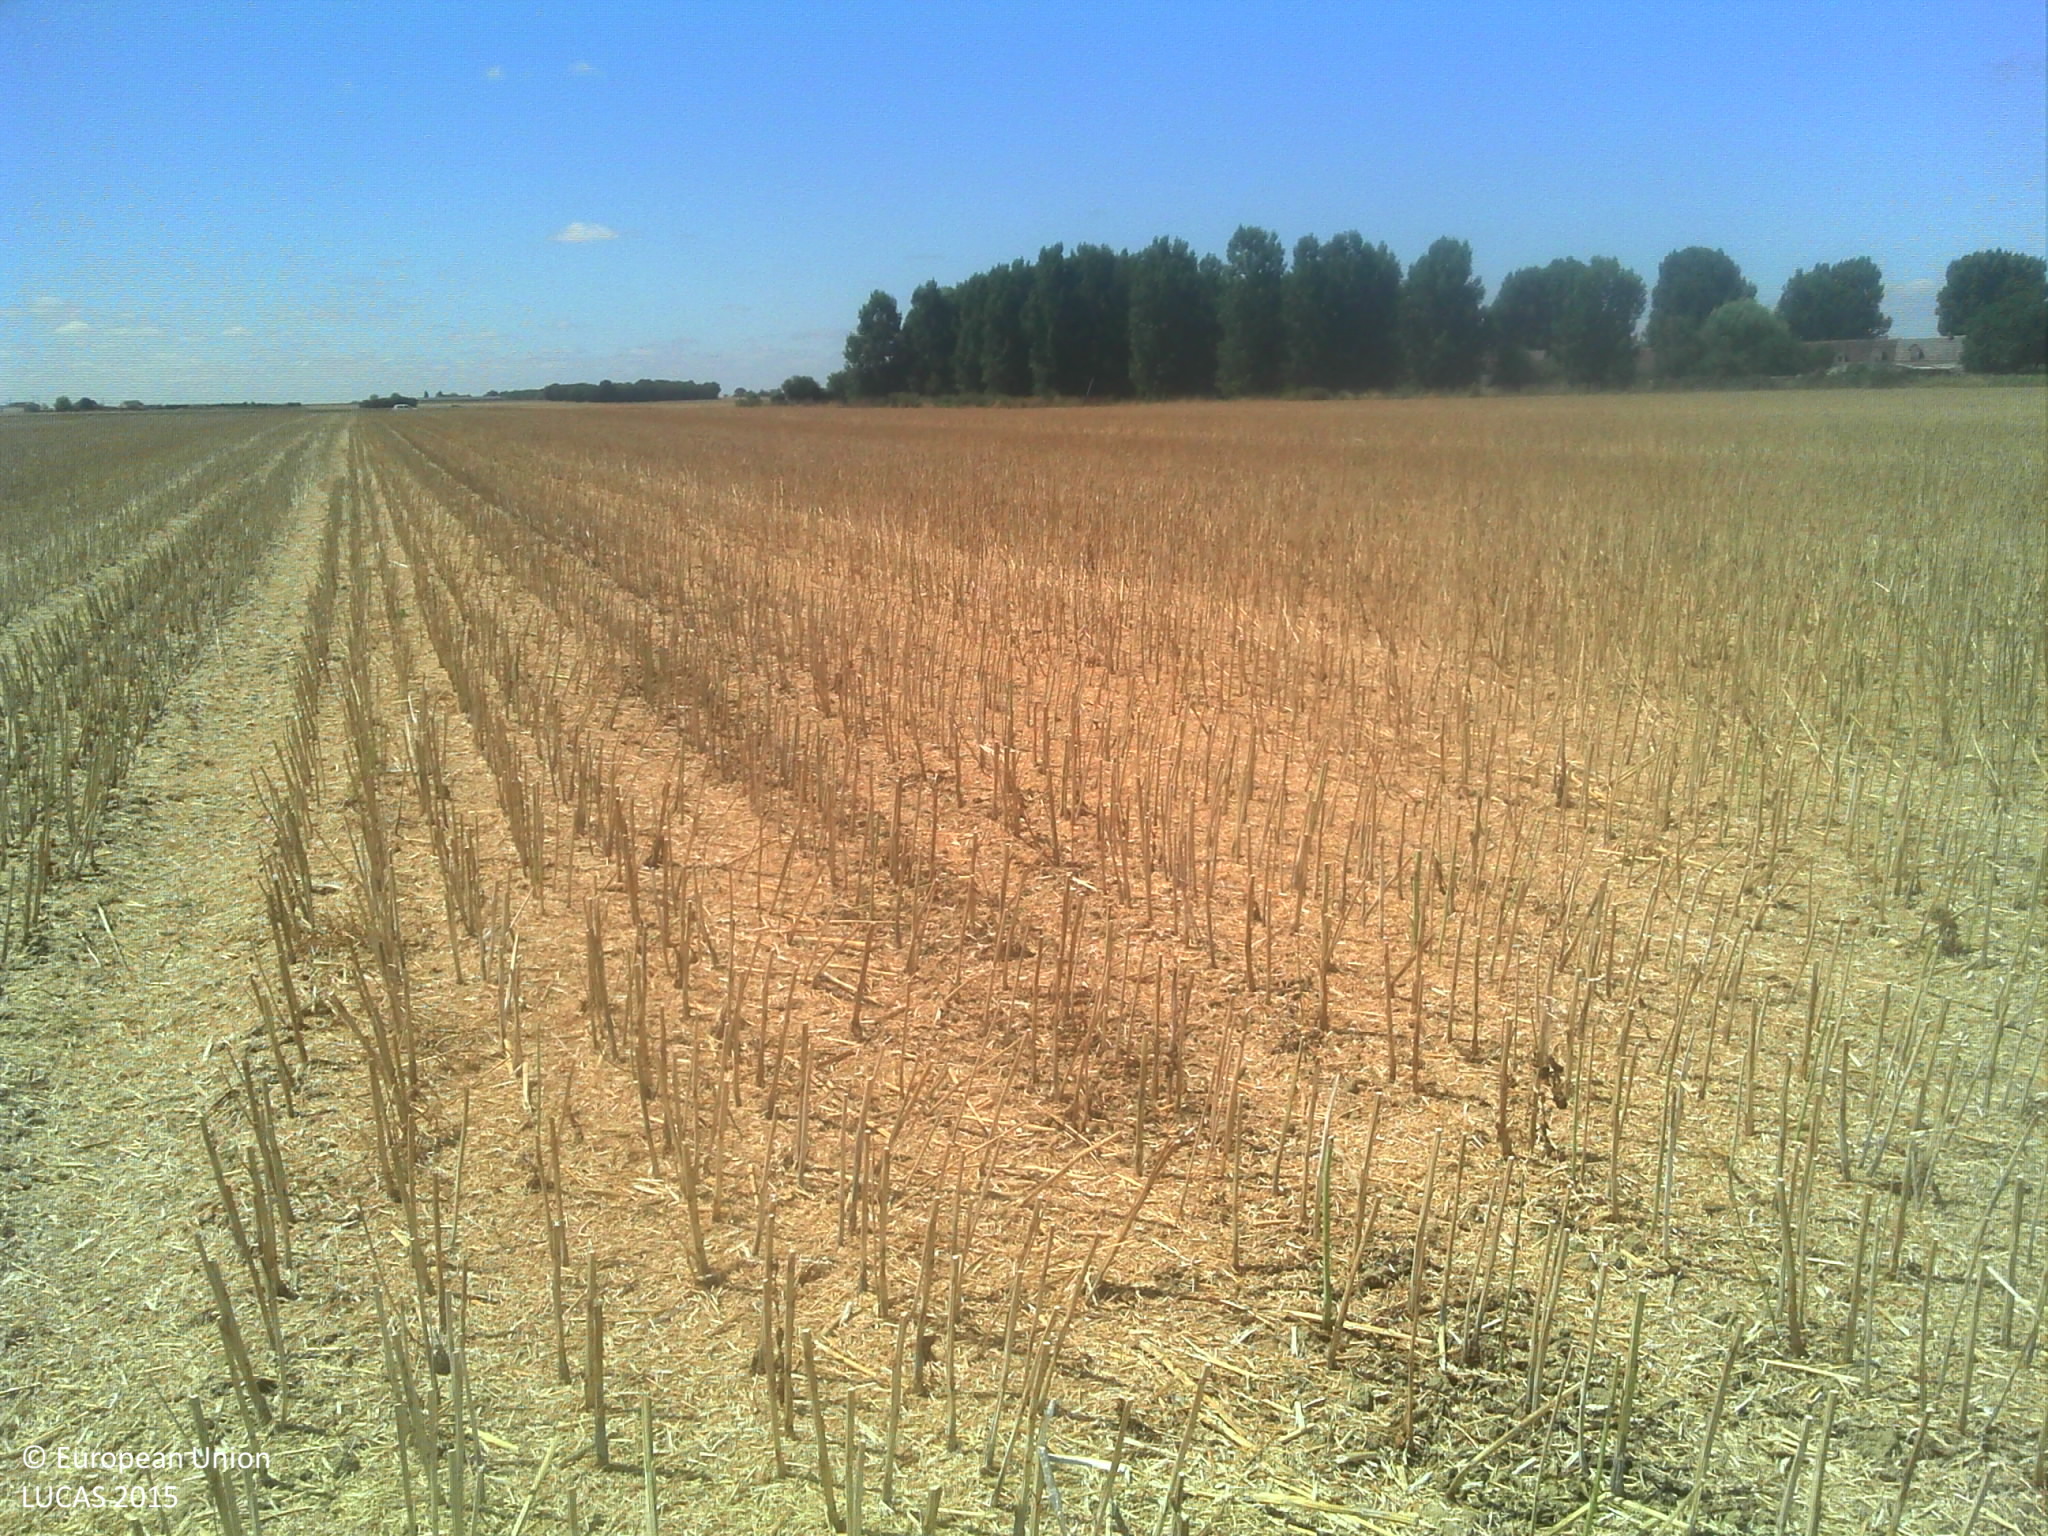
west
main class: Cropland
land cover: Rape and turnip rape
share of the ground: < 10 %
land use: Agriculture (excluding fallow land and kitchen gardens)
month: July
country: FR
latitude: 47.9152
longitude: 1.2993
